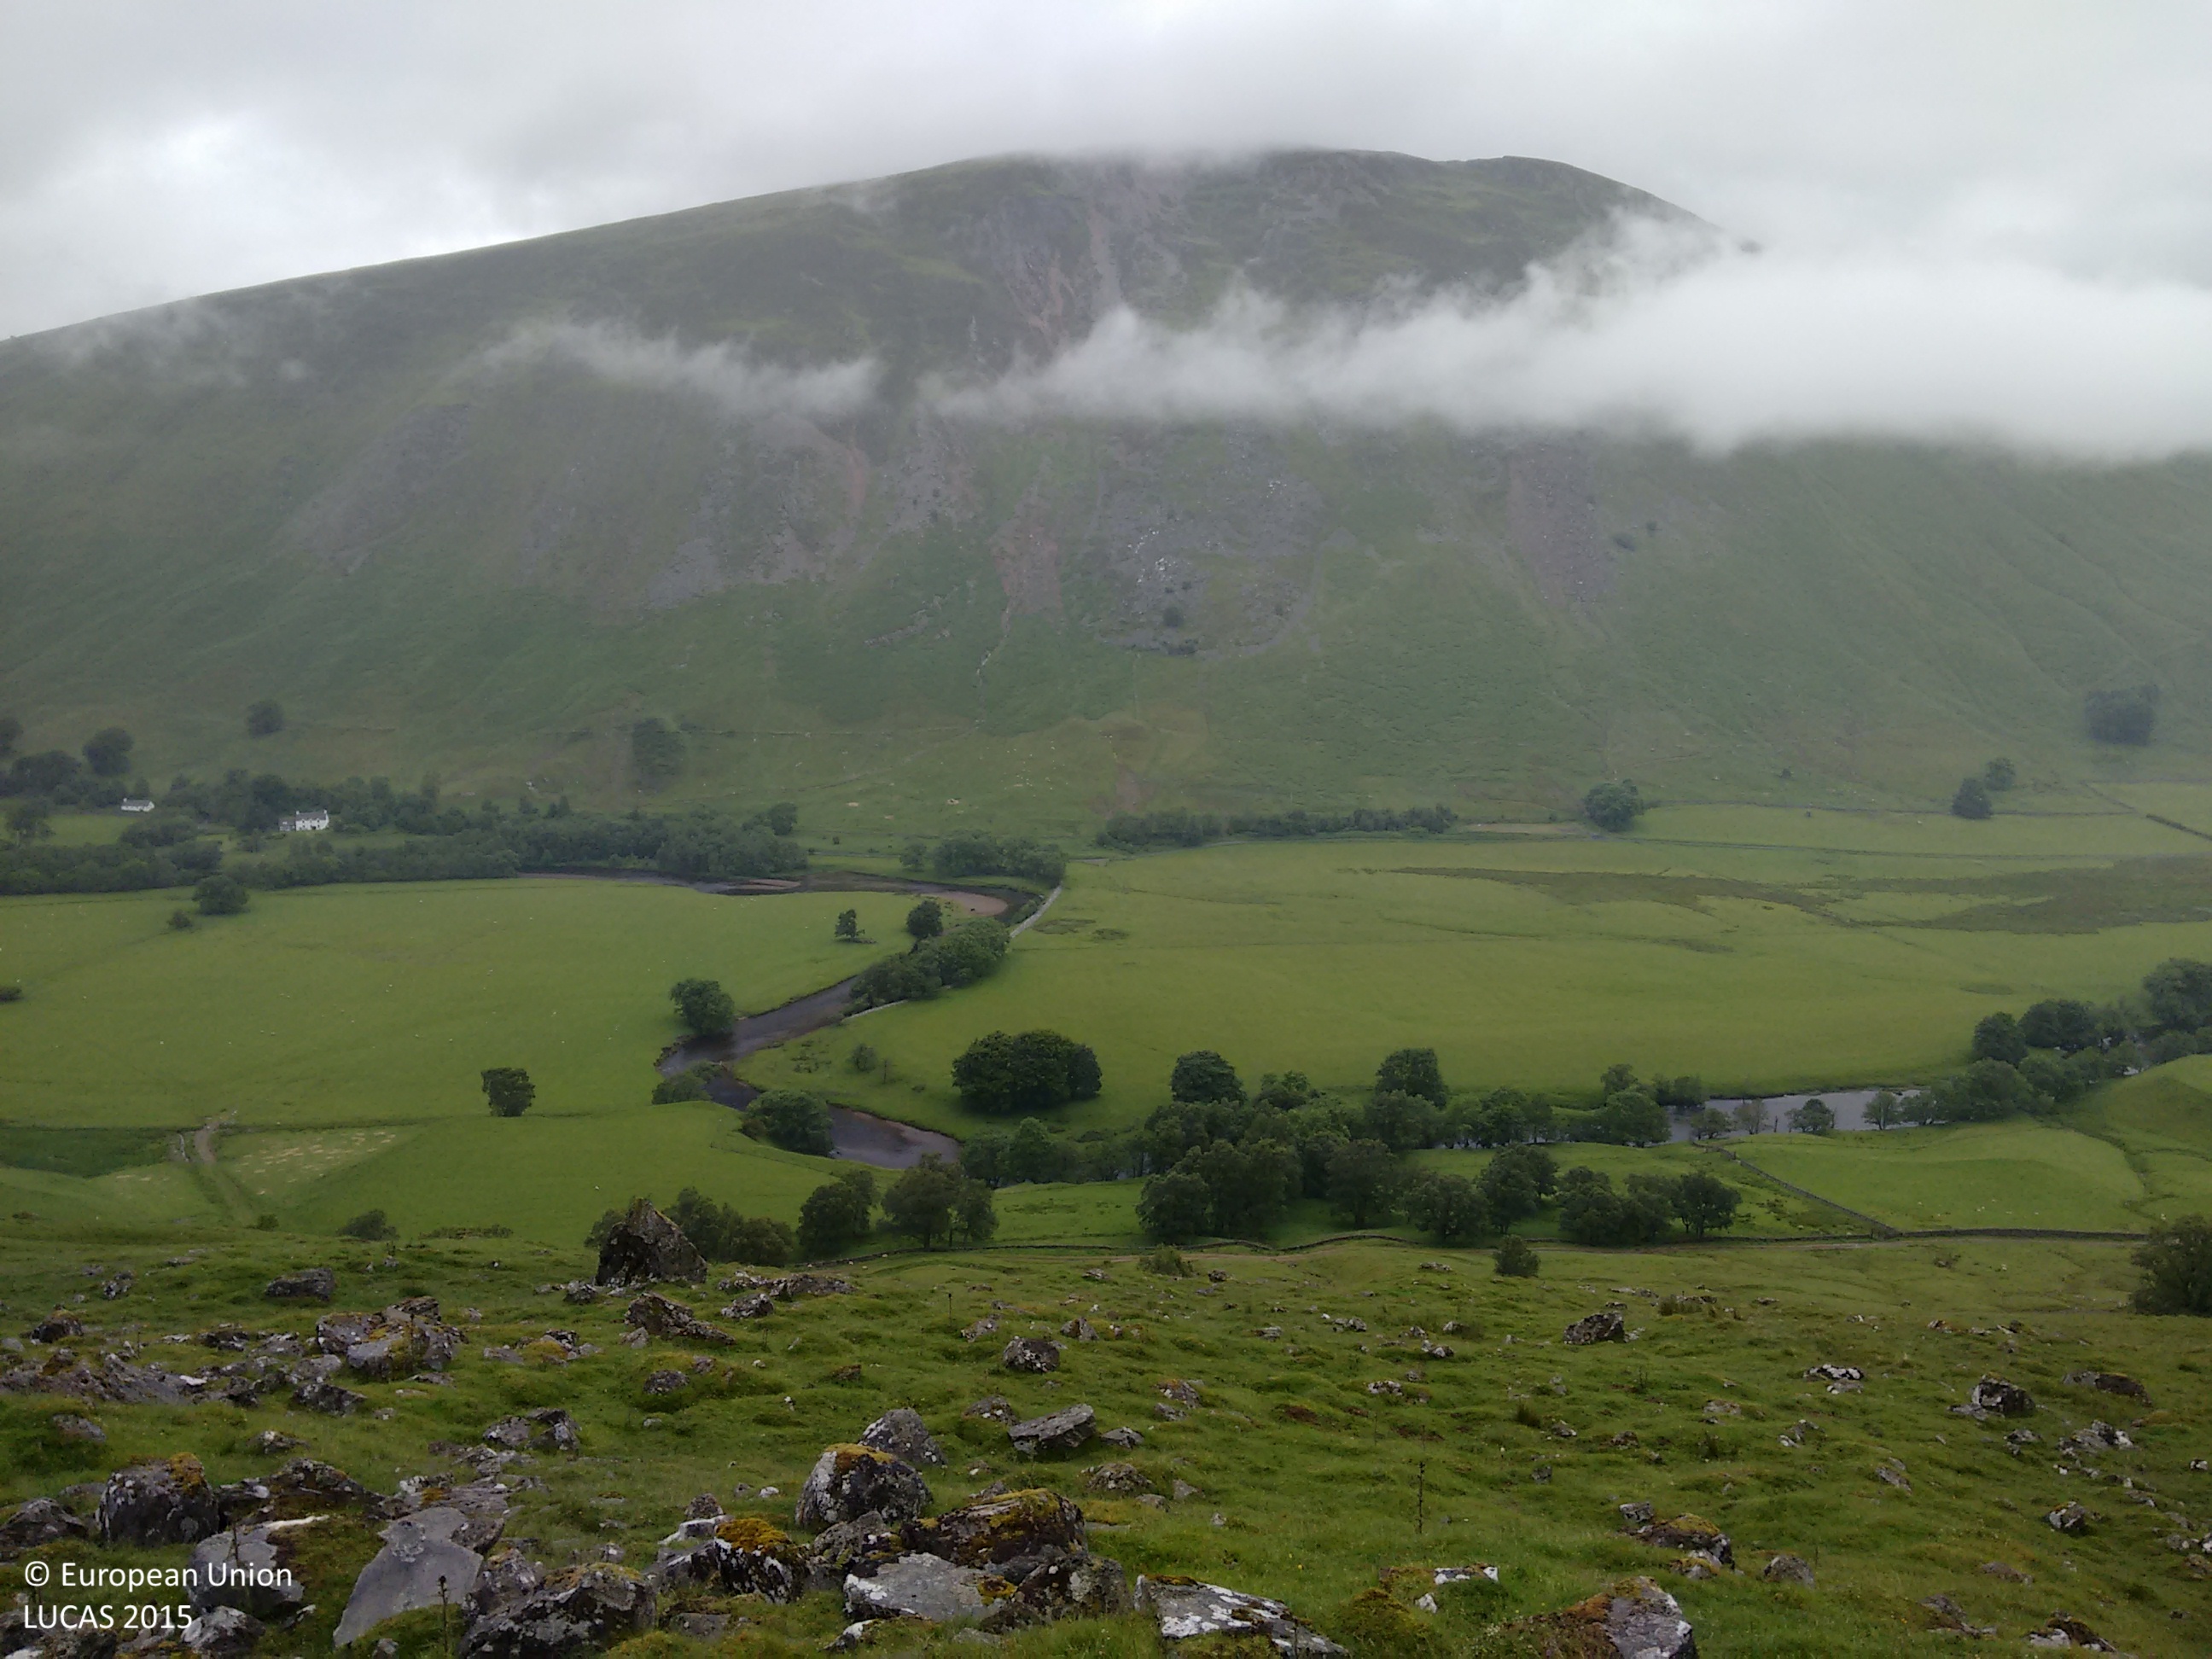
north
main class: Grassland
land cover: Grassland without tree/shrub cover
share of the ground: > 75 %
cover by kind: herbaceous plants 90 %, lichens and mosses 10 %
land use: Agriculture (excluding fallow land and kitchen gardens)
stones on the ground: < 10 %
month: July
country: GB
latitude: 56.5915
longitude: -4.2745
